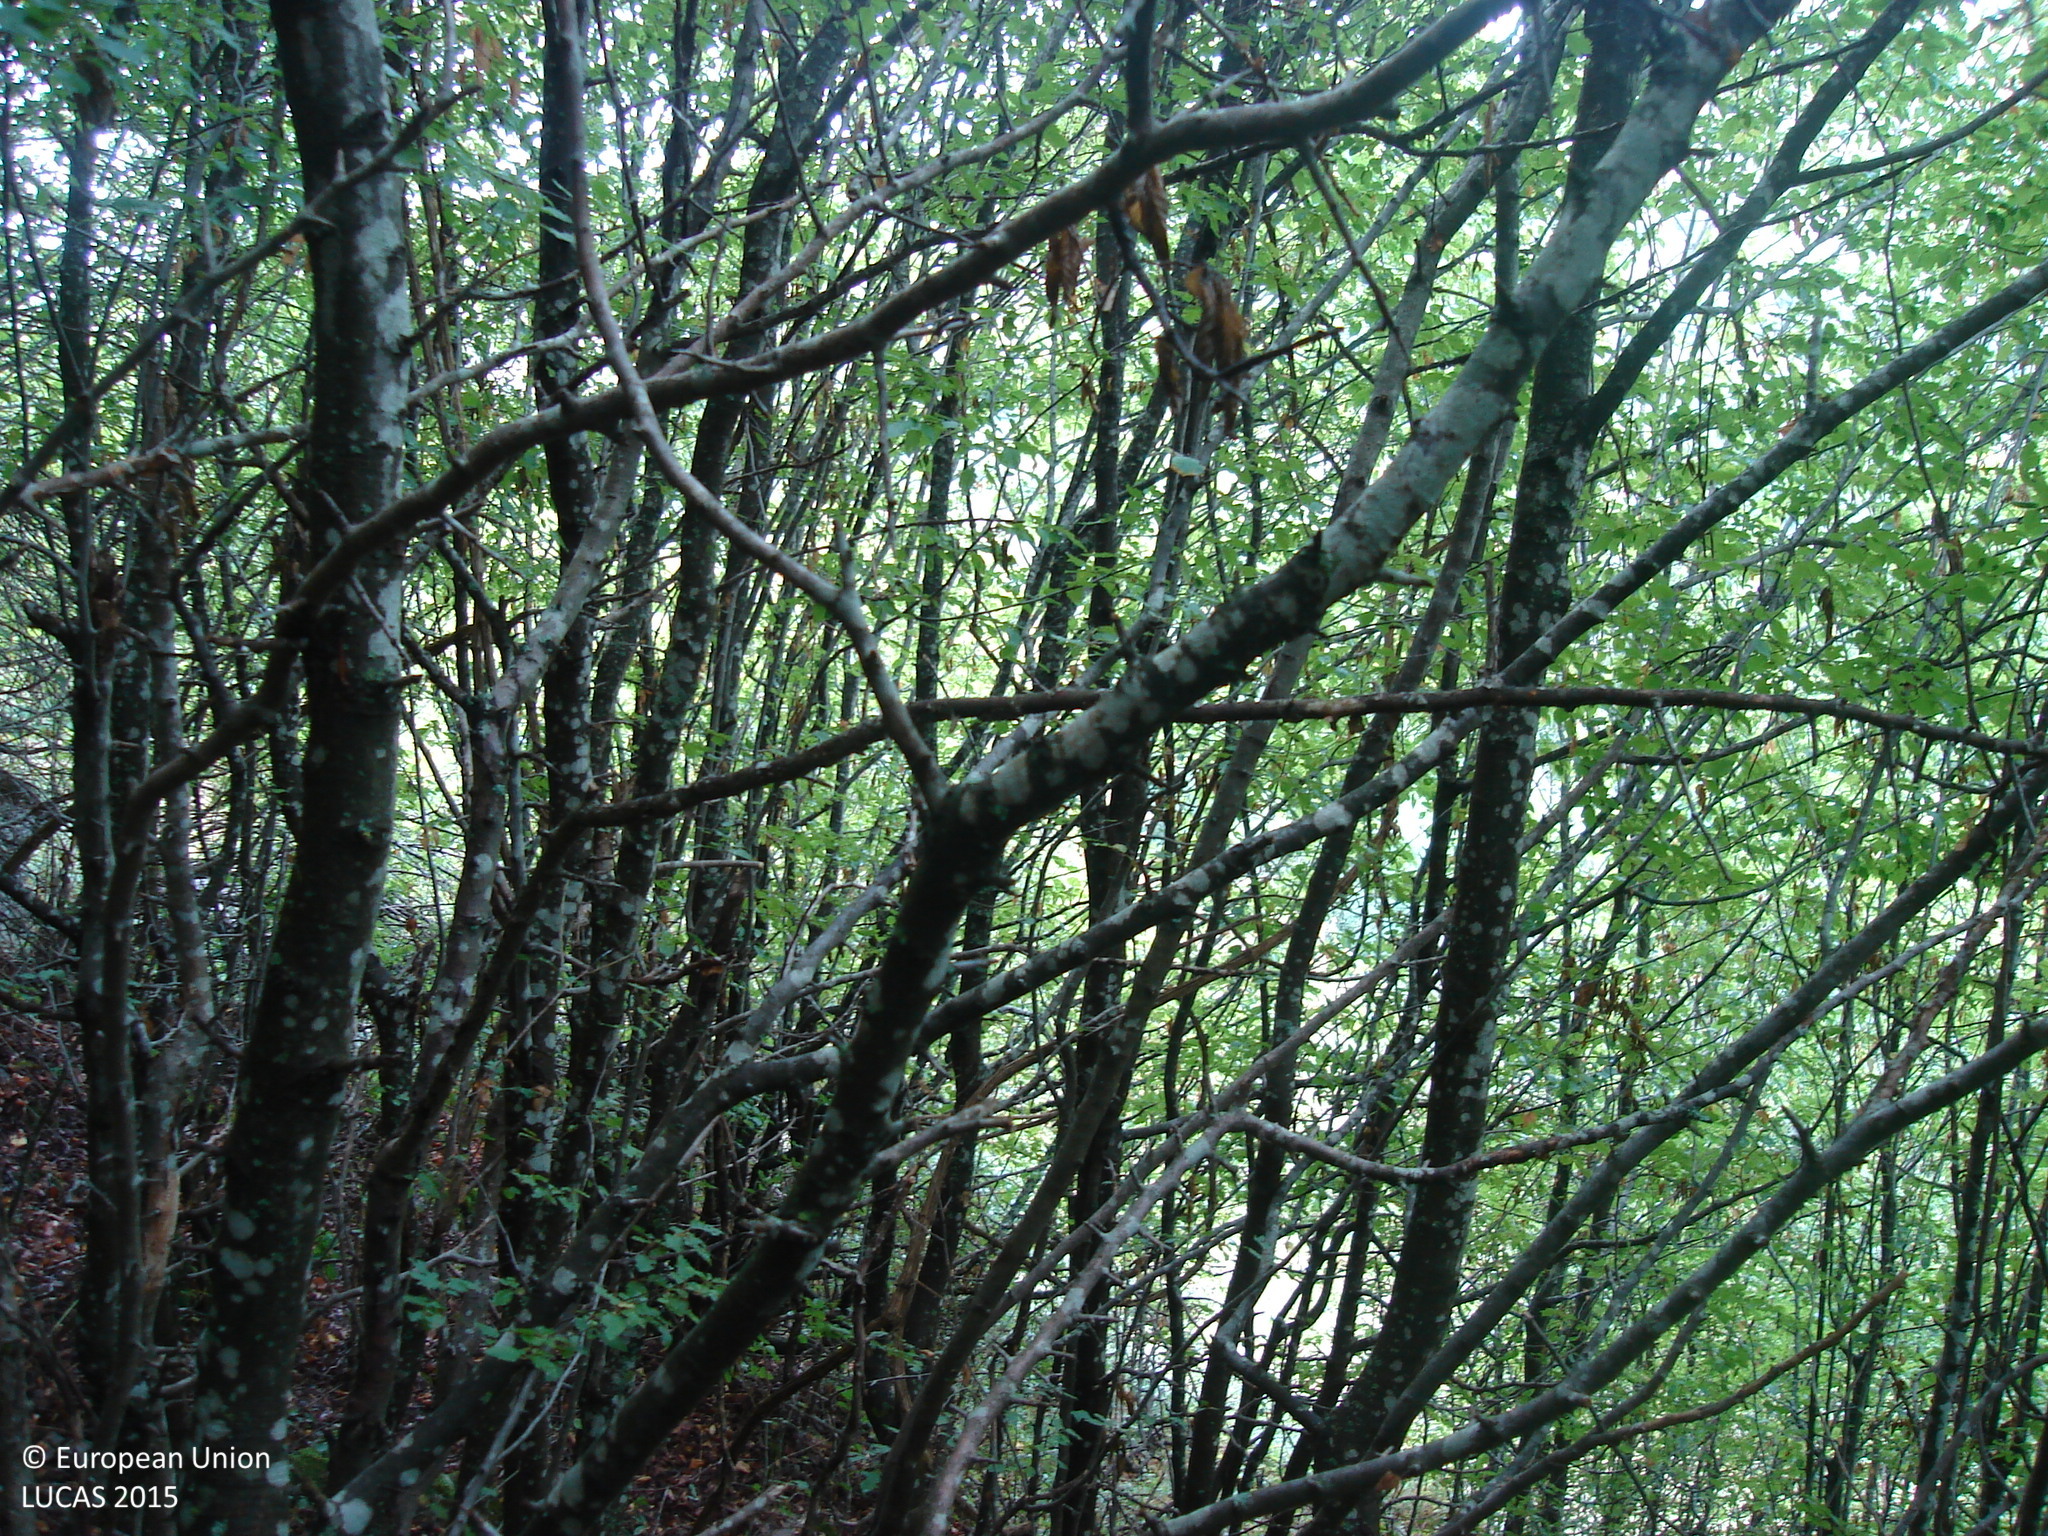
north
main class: Woodland
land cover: Broadleaved woodland
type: mesophytic deciduous forest
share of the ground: > 75 %
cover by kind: broadleaved forest trees 80 %, consolidated bare surface 20 %
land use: Forestry
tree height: > 5 m
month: September
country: BG
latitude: 43.0278
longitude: 23.2039
